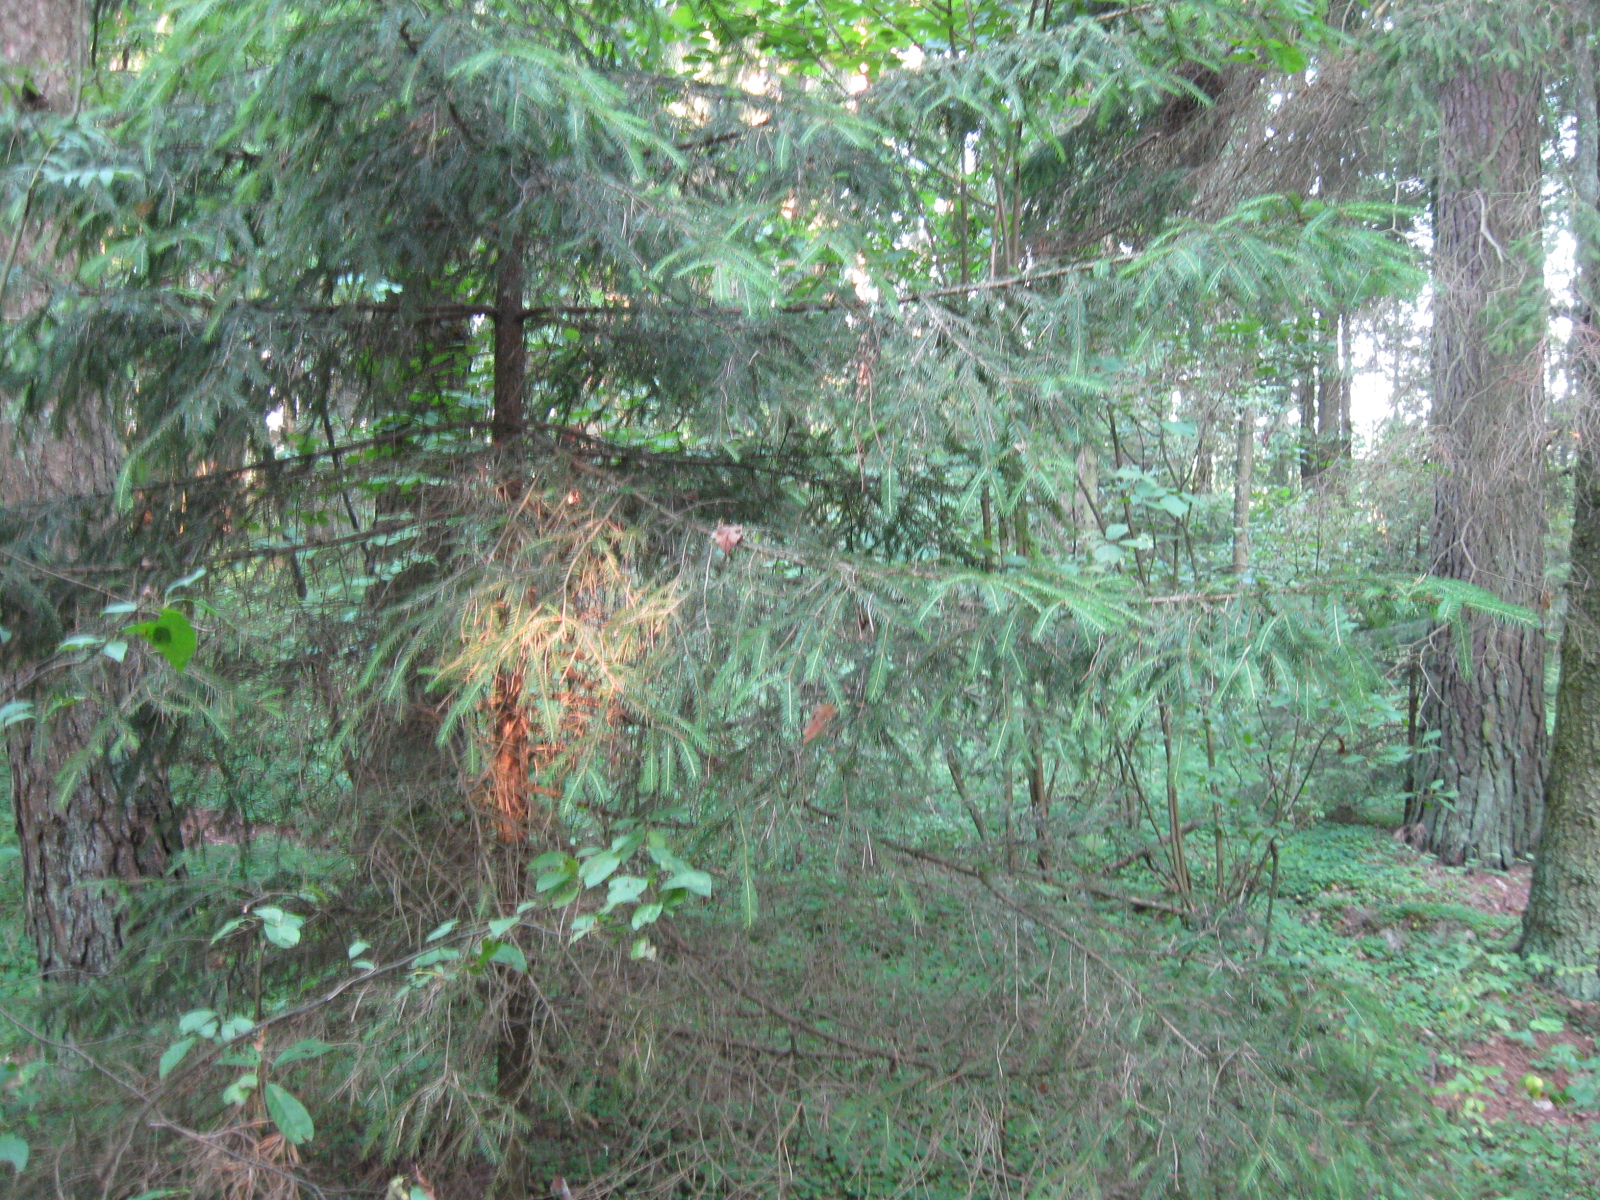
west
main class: Woodland
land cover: Other mixed woodland
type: hemiboreal forest and nemoral coniferous forest and mixed broadleaved-coniferous forest
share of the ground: > 75 %
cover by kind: coniferous forest trees 65 %, broadleaved forest trees 30 %, herbaceous plants 5 %
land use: Forestry
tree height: > 5 m
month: August
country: LT
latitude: 54.8107
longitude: 23.3507
